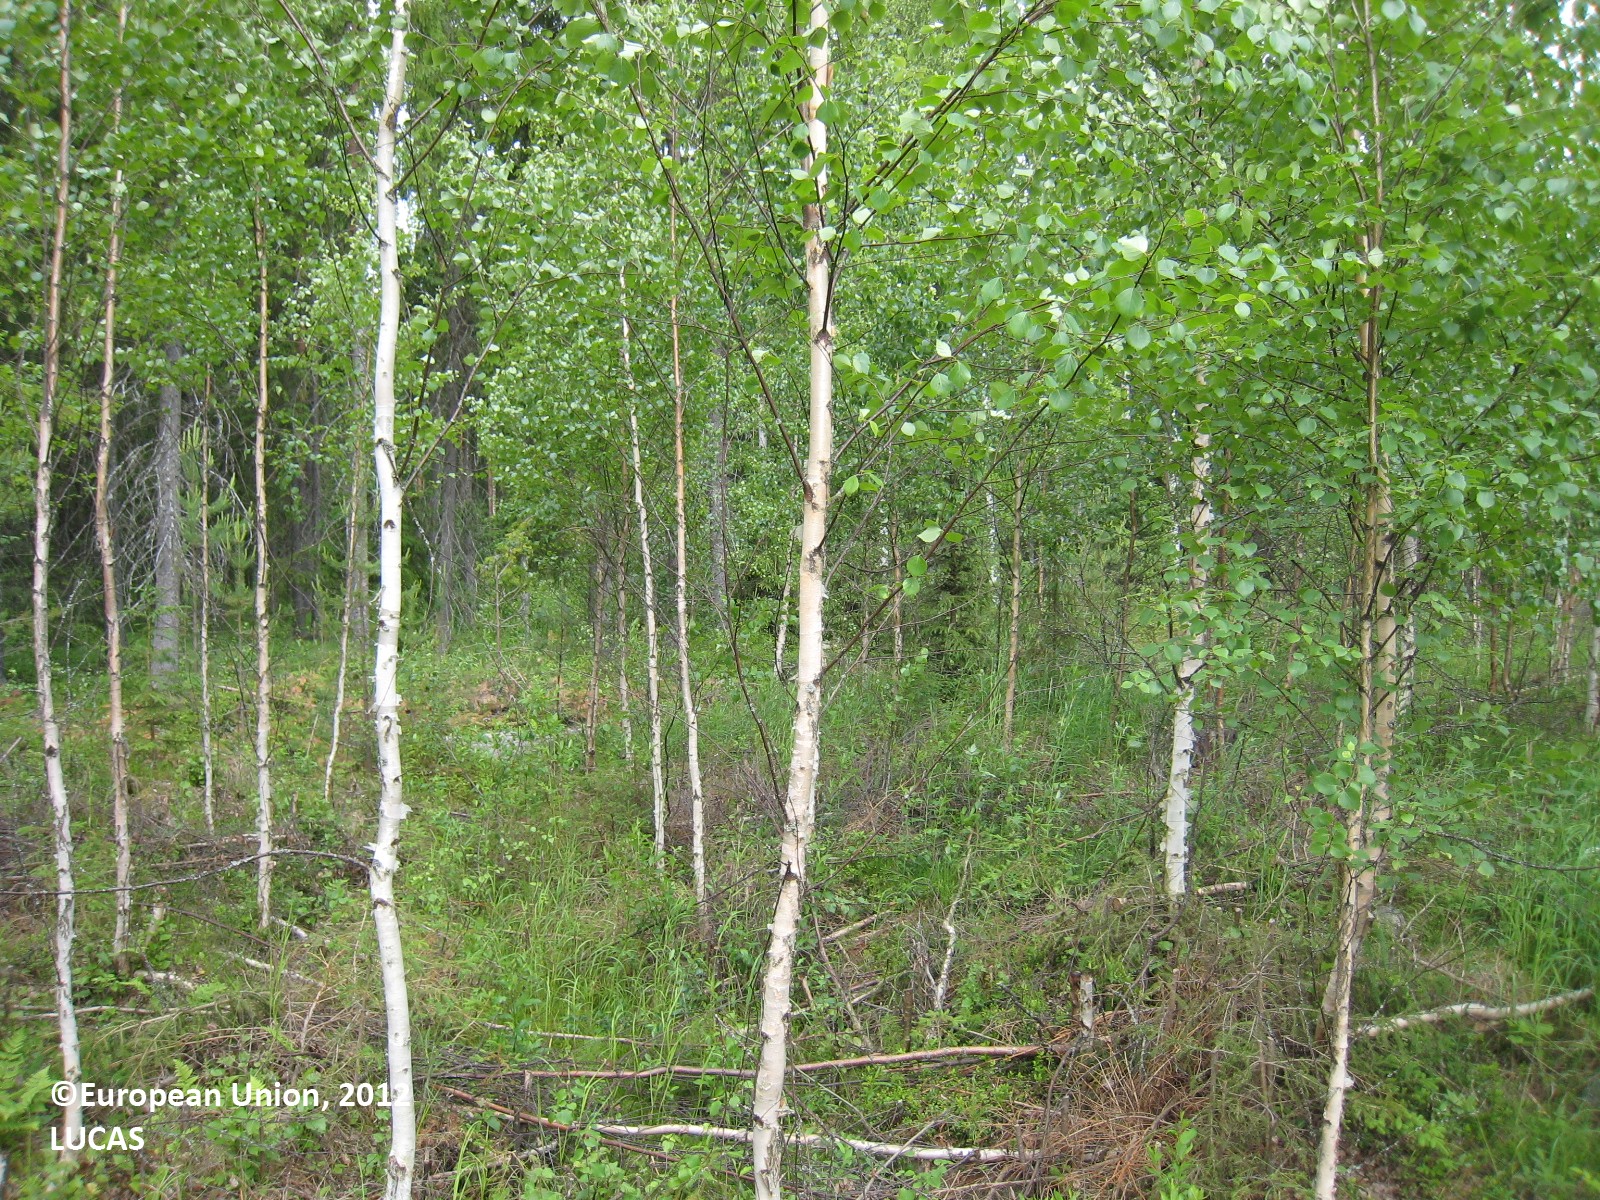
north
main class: Woodland
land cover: Broadleaved woodland
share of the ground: 50 - 75 %
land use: Forestry
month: June
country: FI
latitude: 62.2223
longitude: 26.3901
